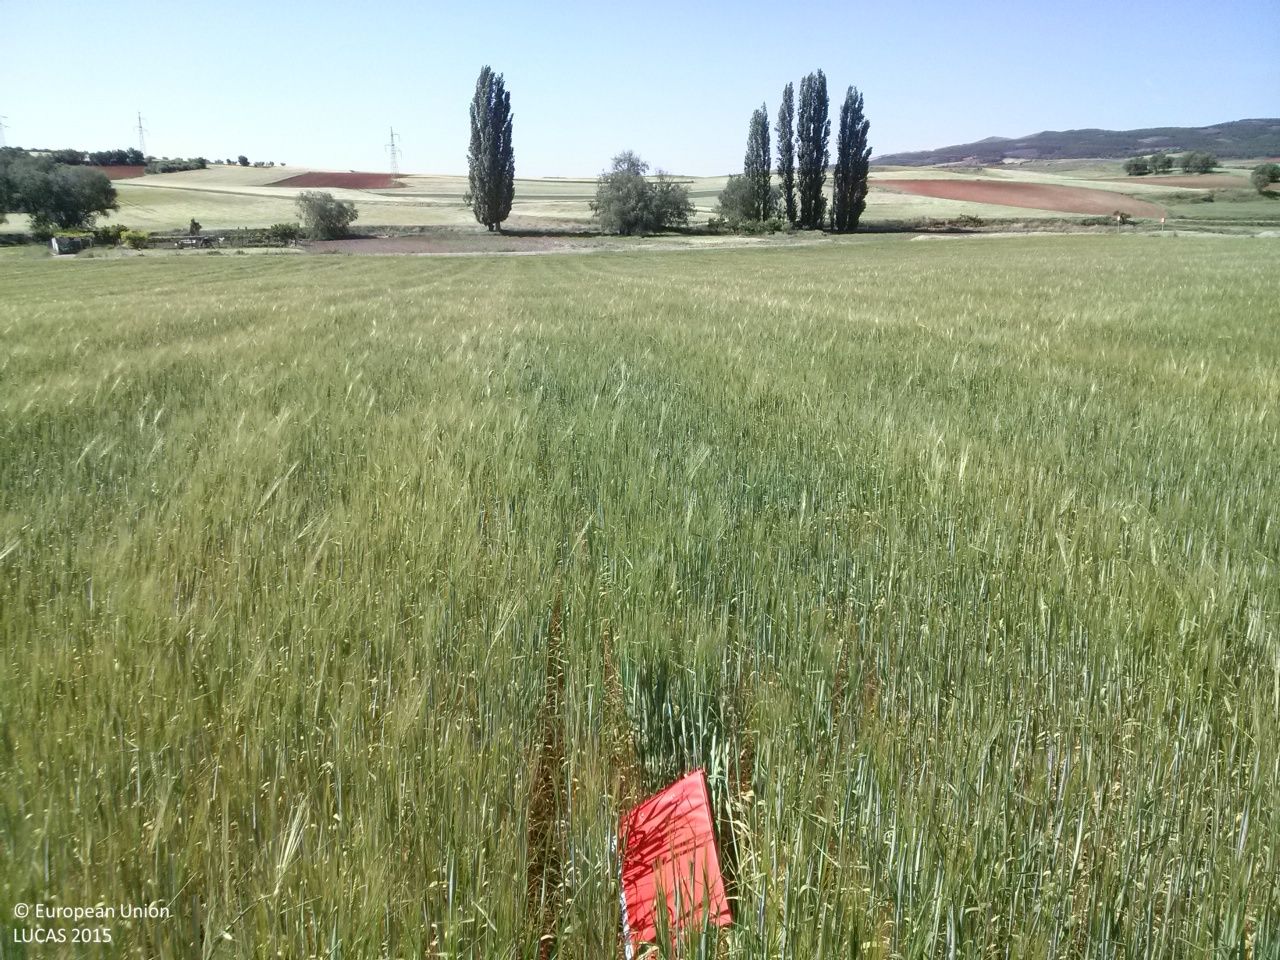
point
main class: Cropland
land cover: Barley
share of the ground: > 75 %
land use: Agriculture (excluding fallow land and kitchen gardens)
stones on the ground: < 10 %
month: May
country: ES
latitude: 39.9924
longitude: -2.7991
